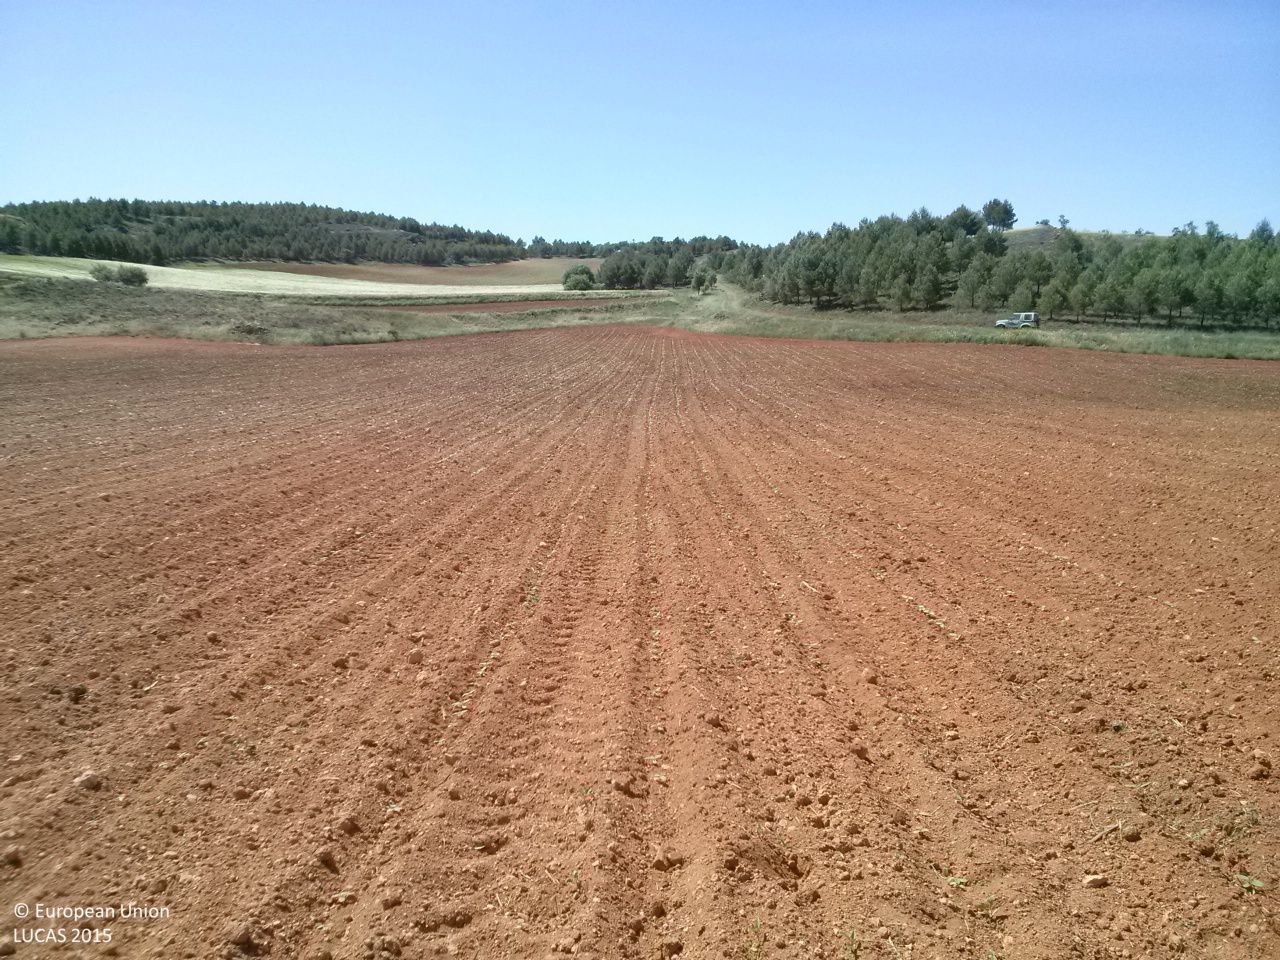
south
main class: Cropland
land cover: Sunflower
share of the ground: < 10 %
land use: Agriculture (excluding fallow land and kitchen gardens)
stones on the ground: < 10 %
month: May
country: ES
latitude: 40.0010
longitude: -2.8719
